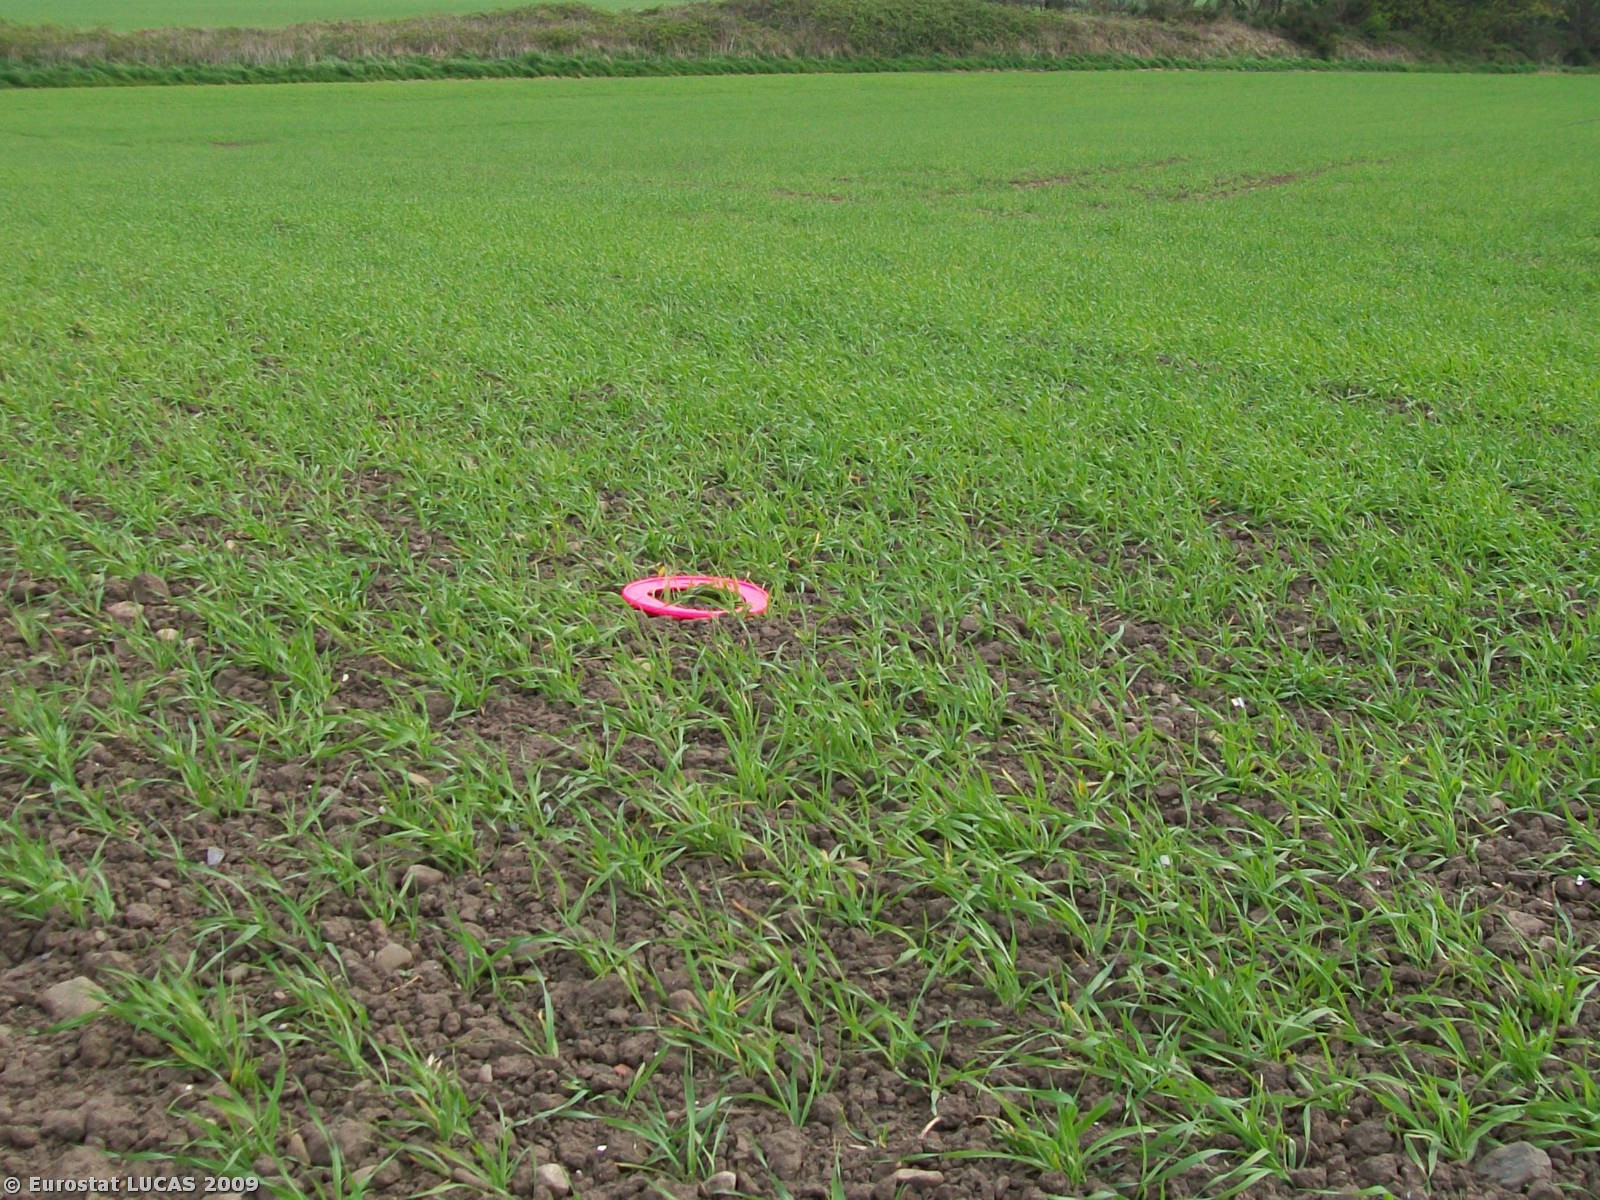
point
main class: Cropland
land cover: Barley
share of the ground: 50 - 75 %
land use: Agriculture (excluding fallow land and kitchen gardens)
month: April
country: GB
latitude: 53.5687
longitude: -2.8612
